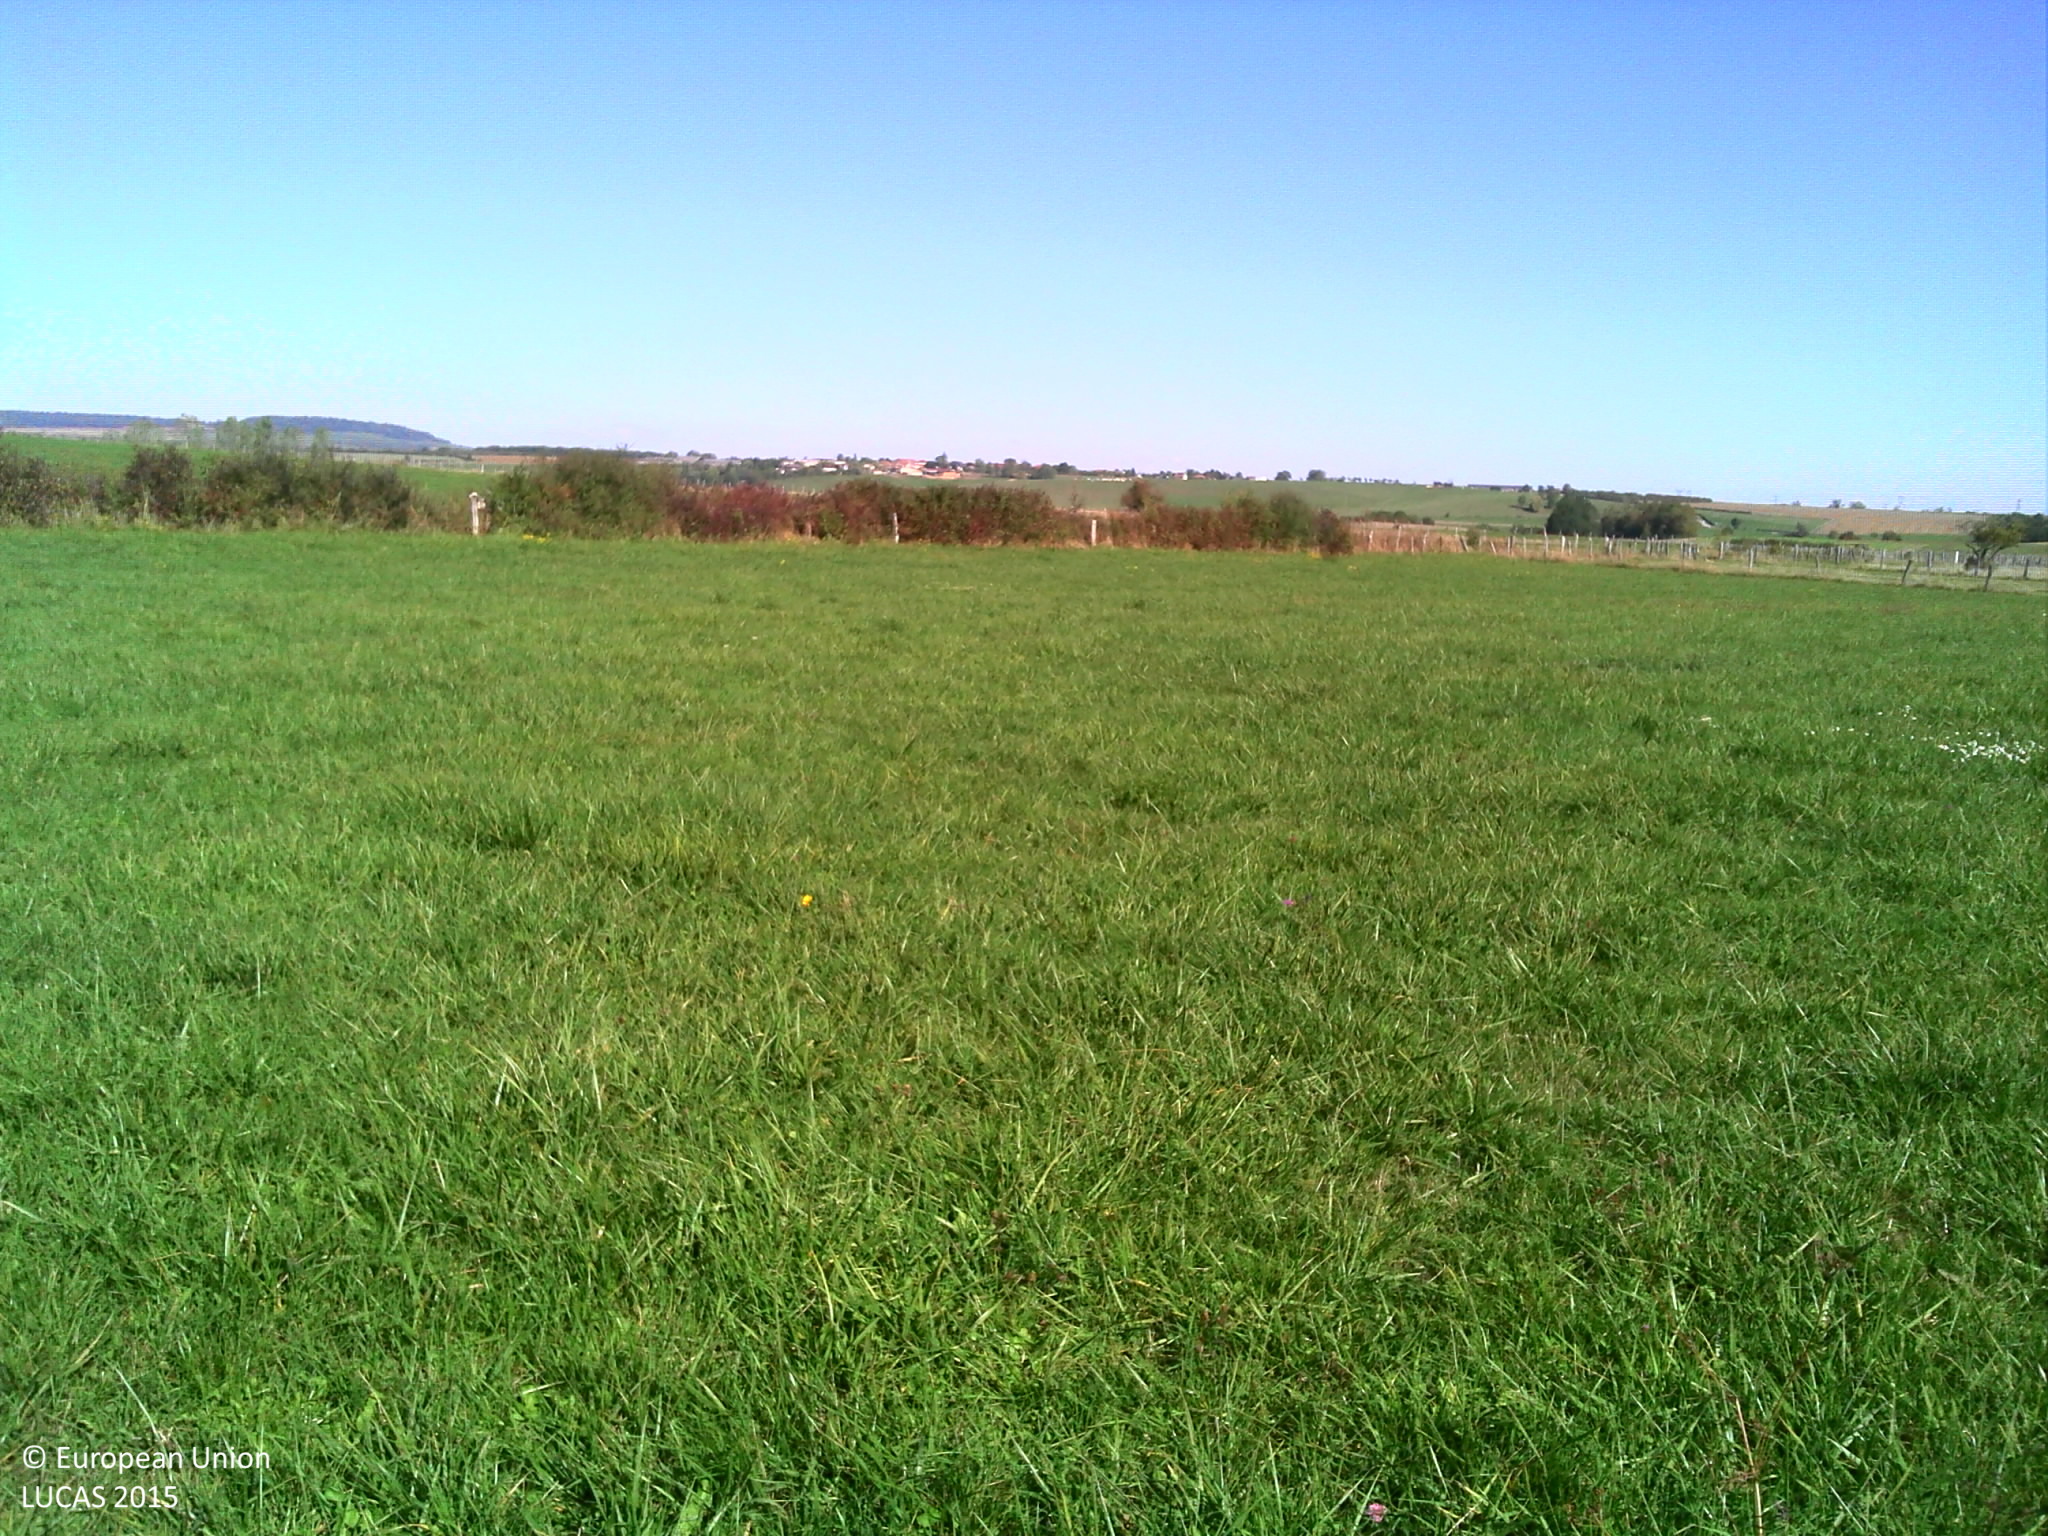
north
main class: Grassland
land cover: Grassland without tree/shrub cover
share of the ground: > 75 %
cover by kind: herbaceous plants 95 %, consolidated bare surface 5 %
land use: Agriculture (excluding fallow land and kitchen gardens)
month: September
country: FR
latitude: 48.4776
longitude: 6.0635
